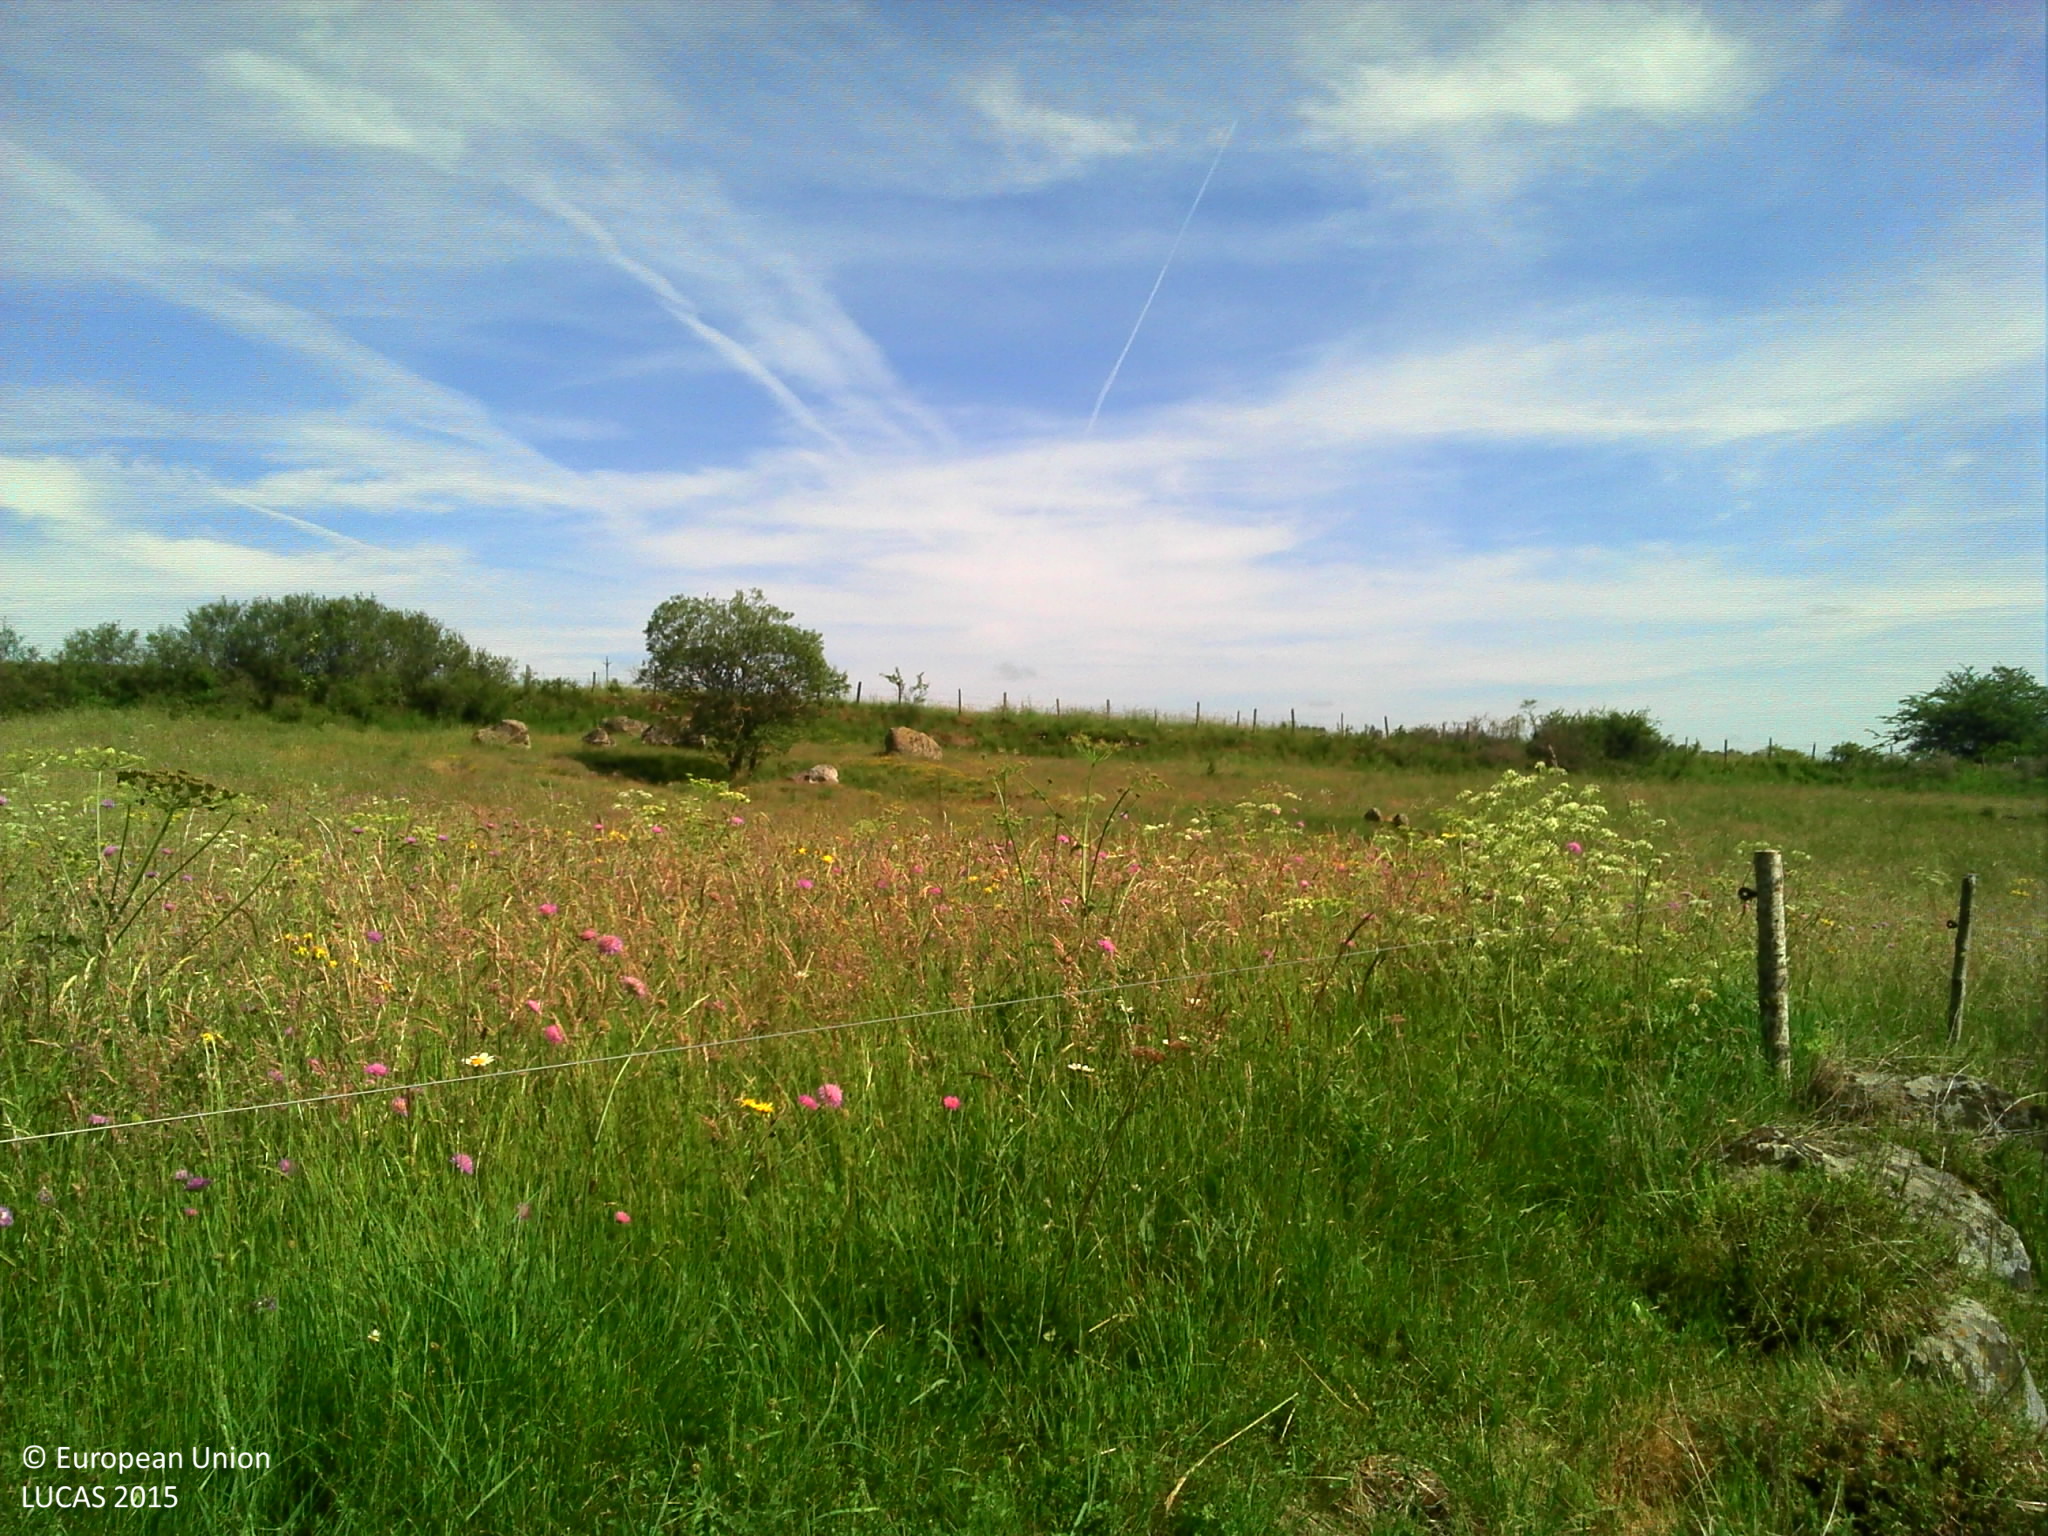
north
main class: Grassland
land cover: Grassland without tree/shrub cover
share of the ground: > 75 %
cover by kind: herbaceous plants 100 %
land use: Agriculture (excluding fallow land and kitchen gardens)
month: June
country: FR
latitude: 45.1398
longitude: 2.9181
